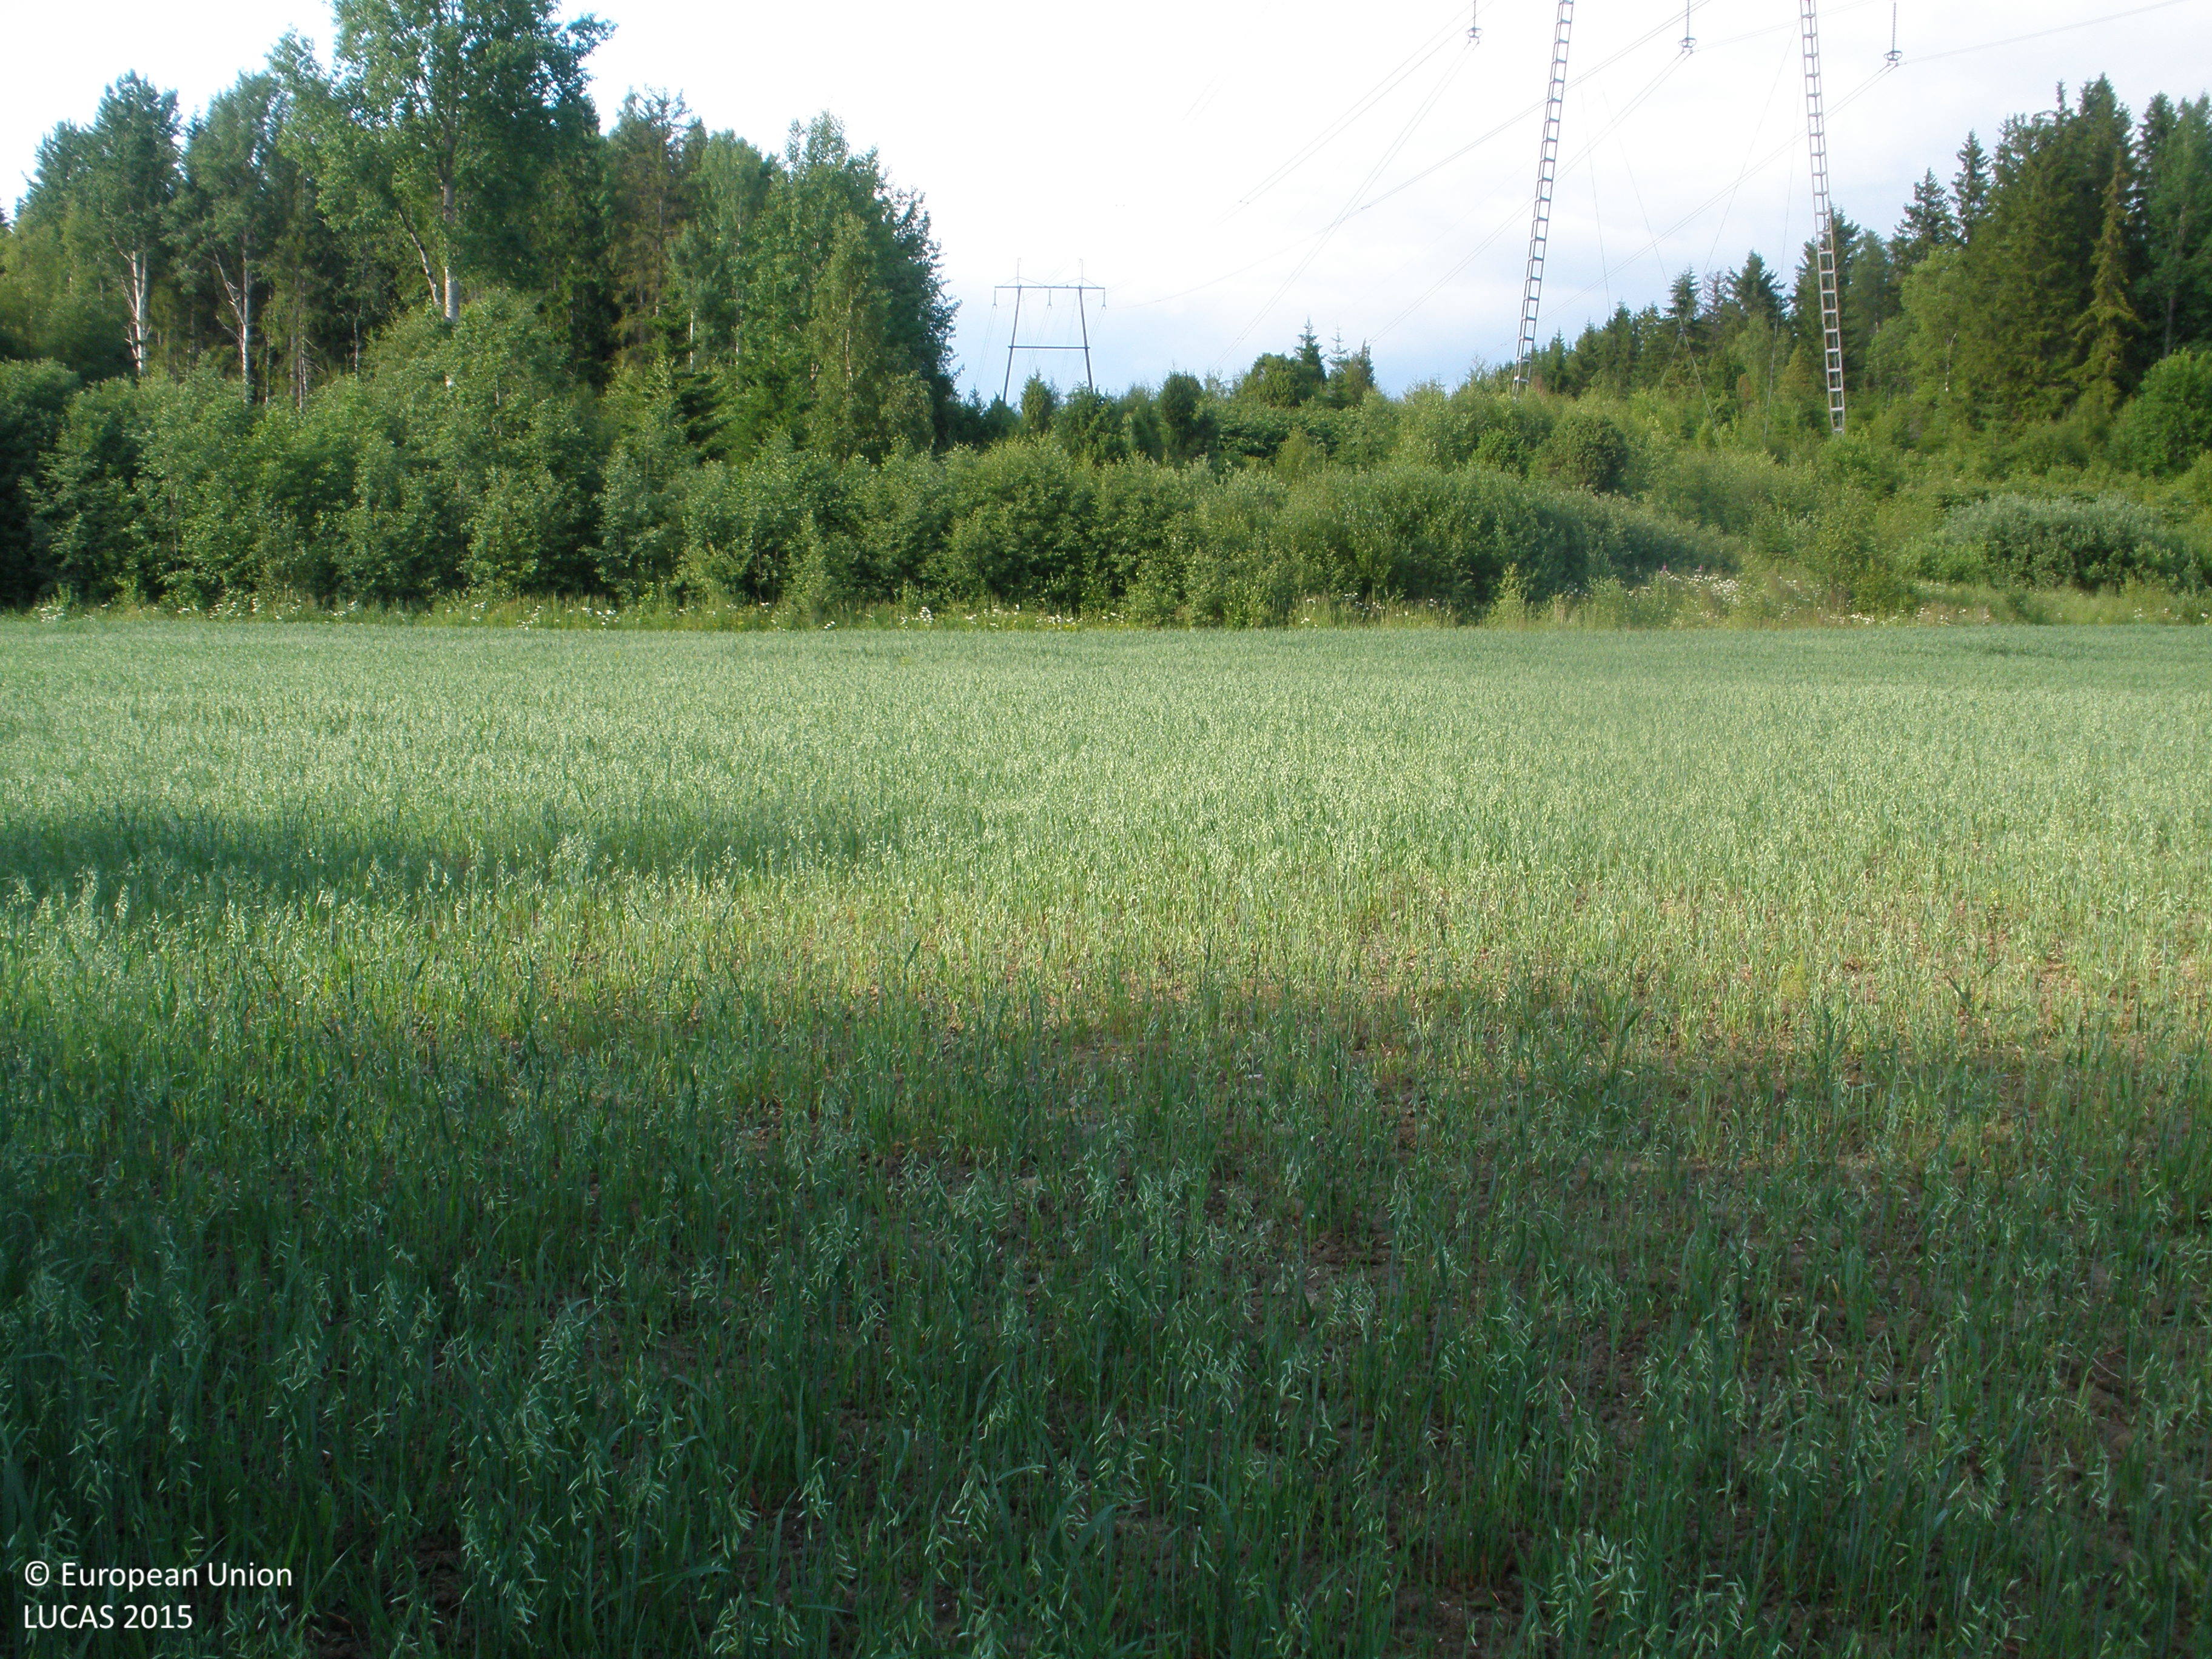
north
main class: Cropland
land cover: Oats
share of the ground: 50 - 75 %
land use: Agriculture (excluding fallow land and kitchen gardens)
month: July
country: FI
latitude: 61.4238
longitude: 23.9757
